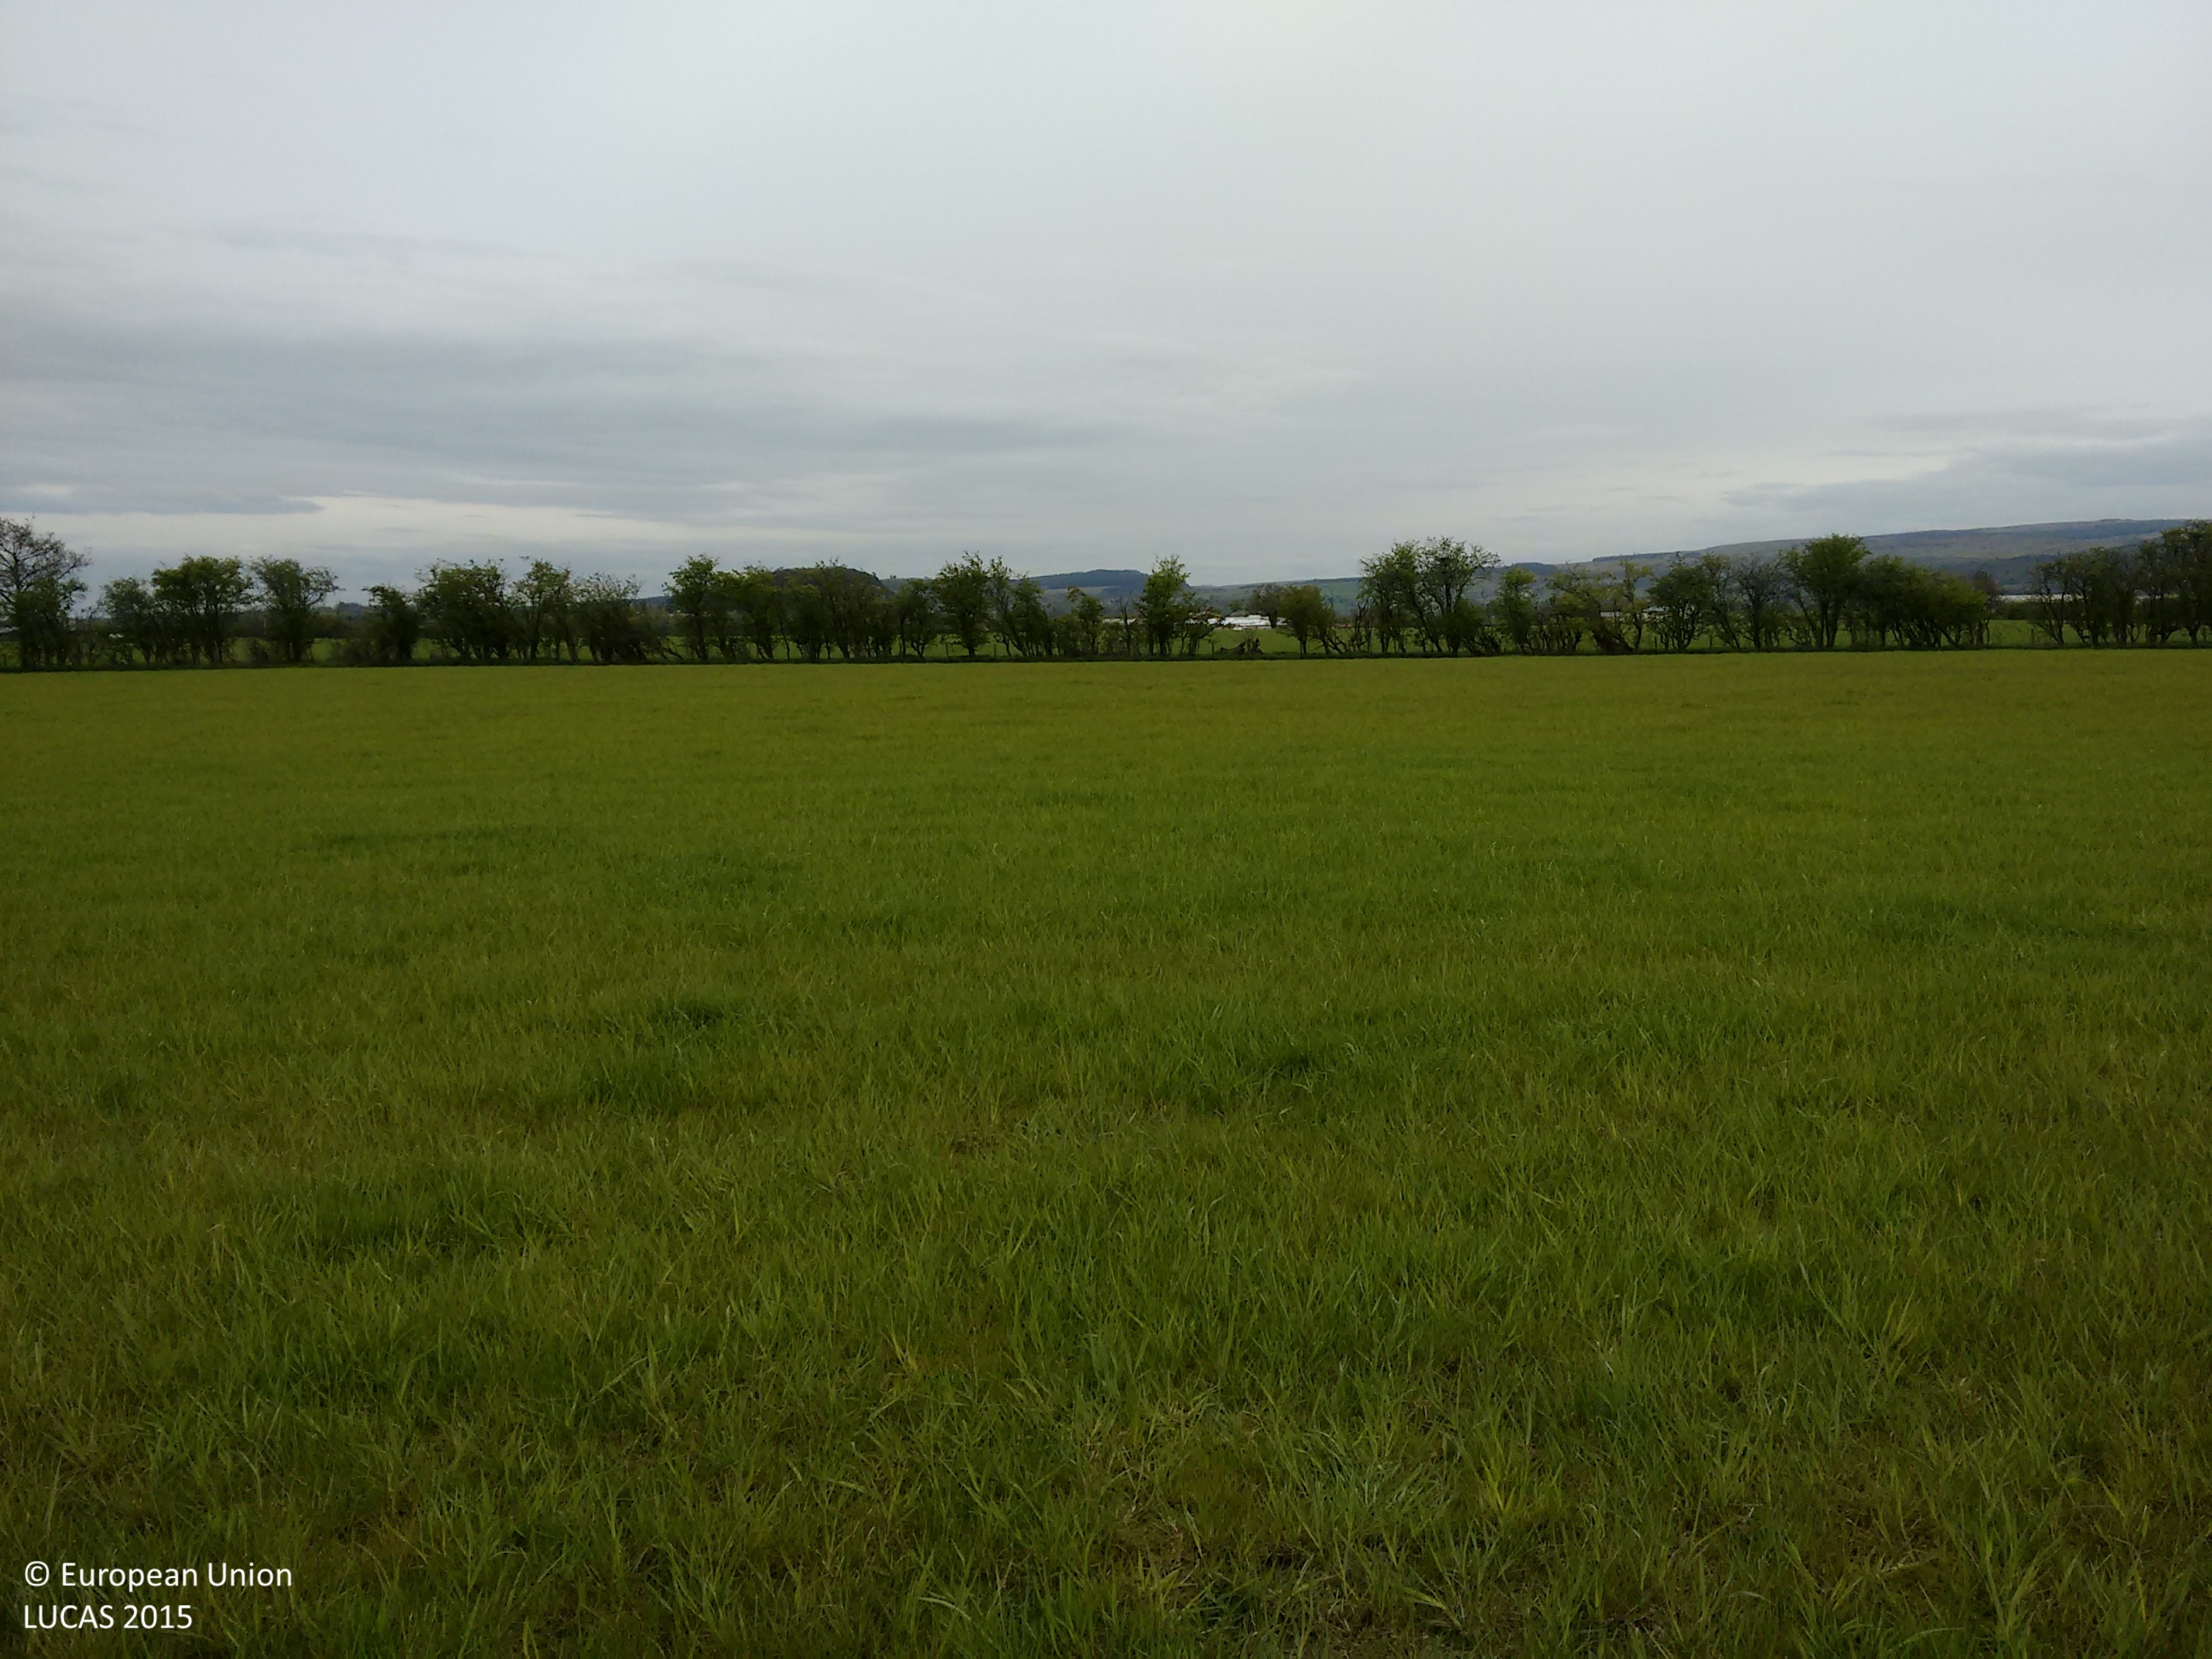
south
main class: Cropland
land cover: Temporary grasslands
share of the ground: > 75 %
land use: Agriculture (excluding fallow land and kitchen gardens)
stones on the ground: < 10 %
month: May
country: GB
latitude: 56.1487
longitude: -3.9776
